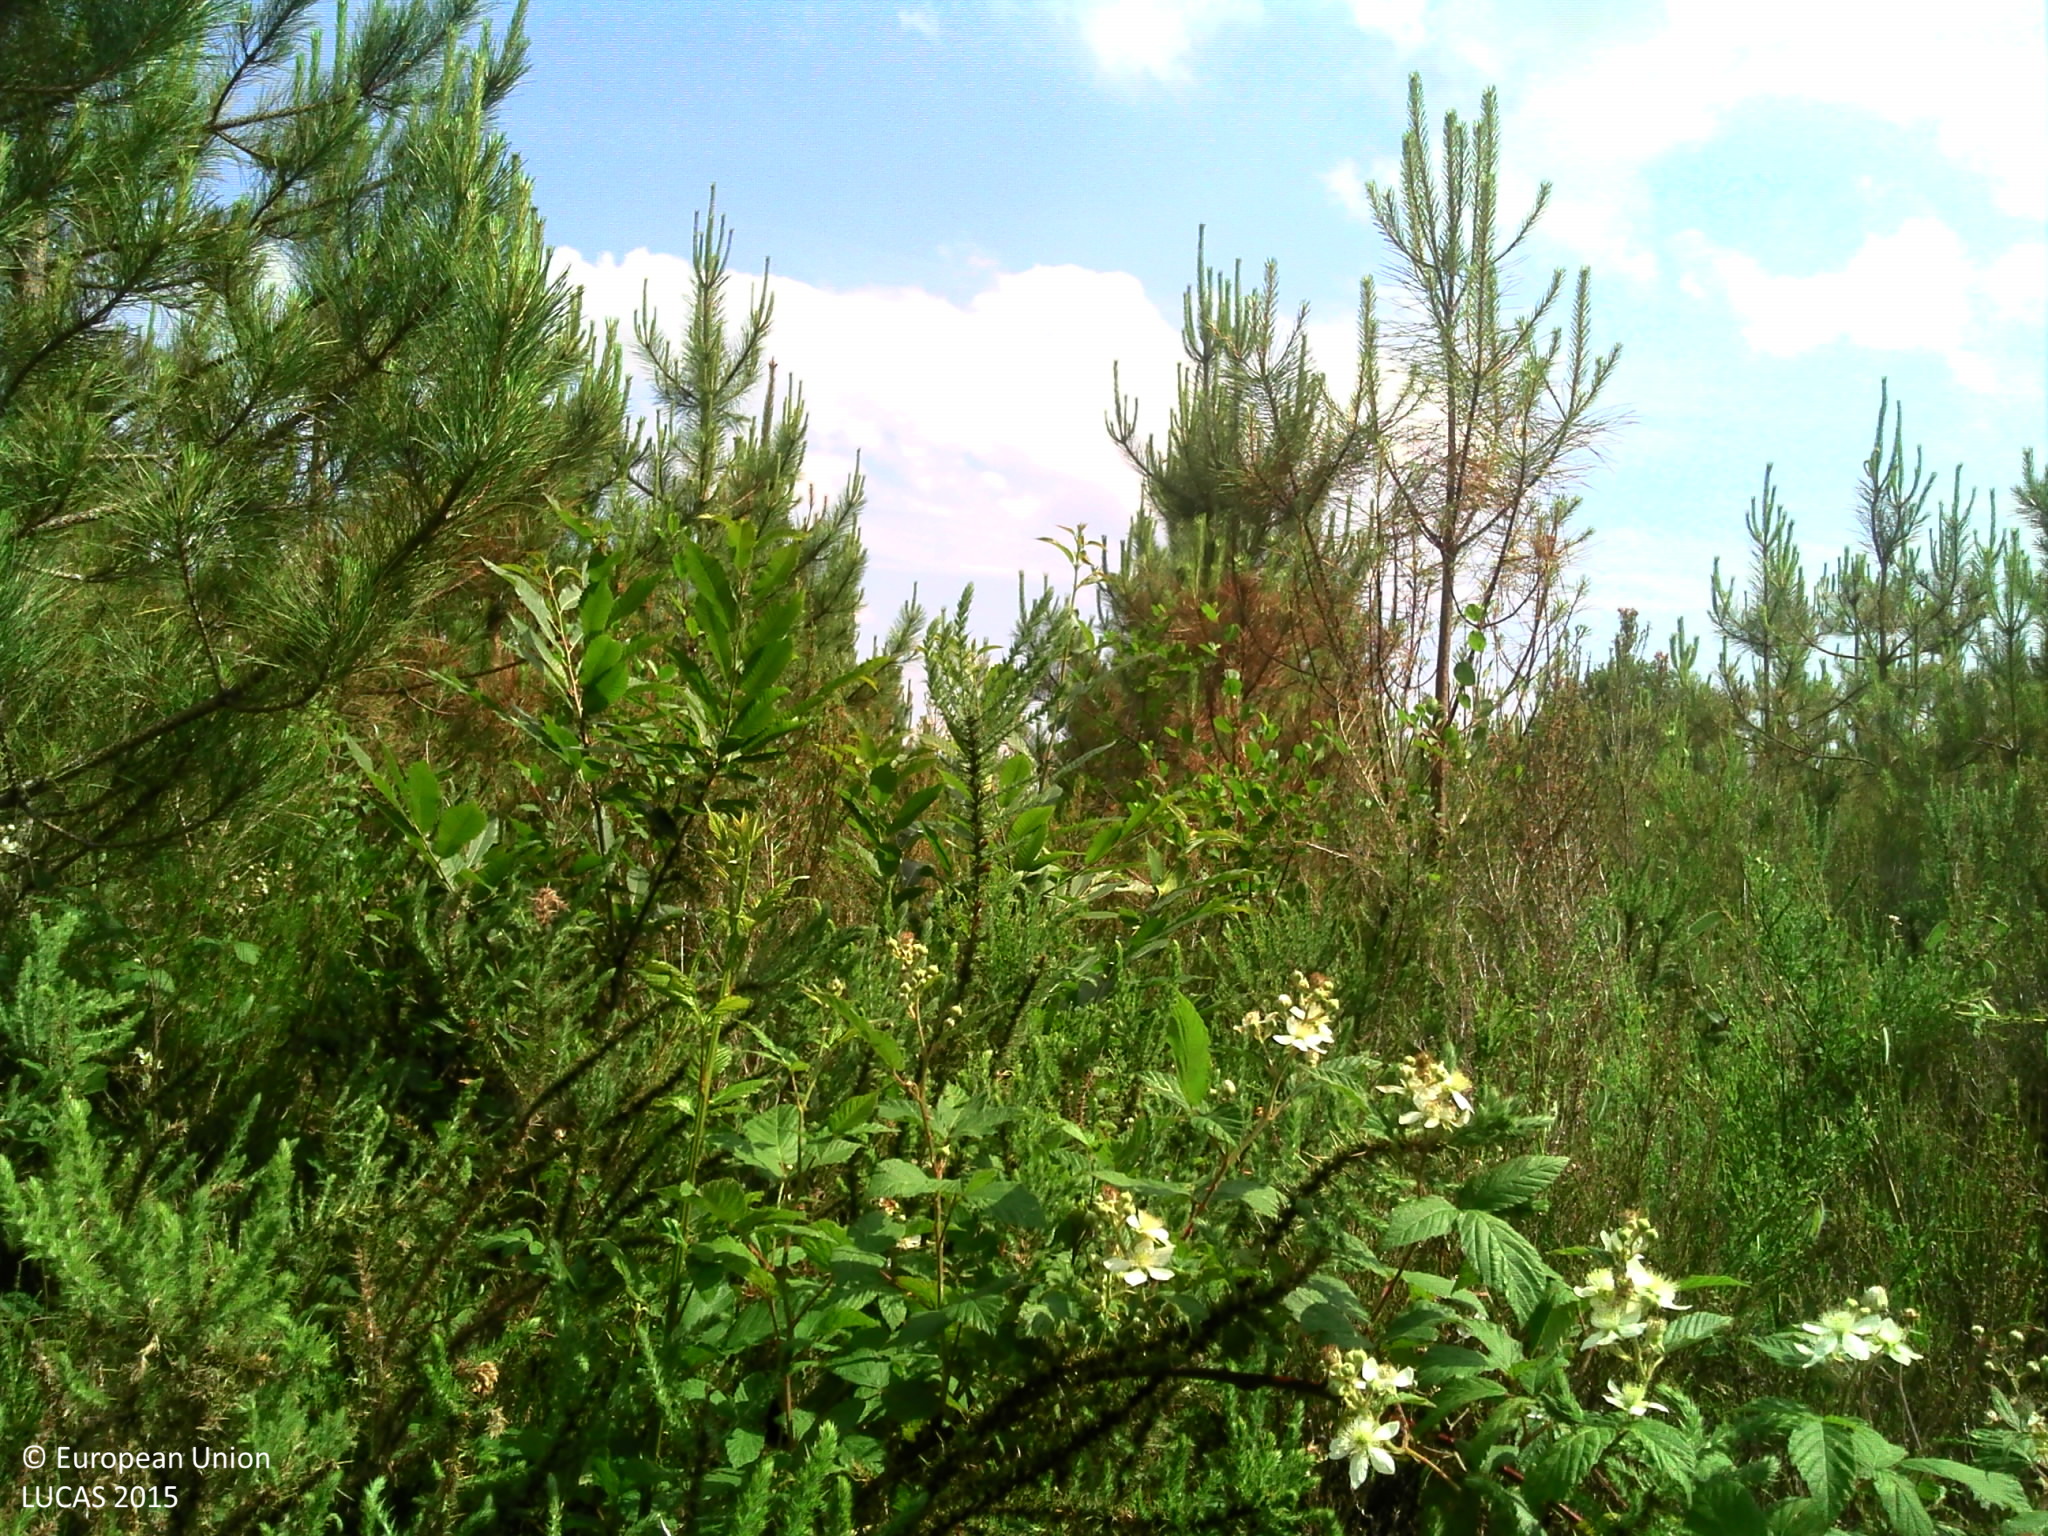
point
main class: Woodland
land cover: Pine dominated coniferous woodland
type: exotic forest
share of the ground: > 75 %
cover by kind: coniferous forest trees 75 %, shrubs 20 %, broadleaved forest trees 5 %
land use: Forestry
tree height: > 5 m
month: June
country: FR
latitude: 47.5928
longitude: 0.6840
